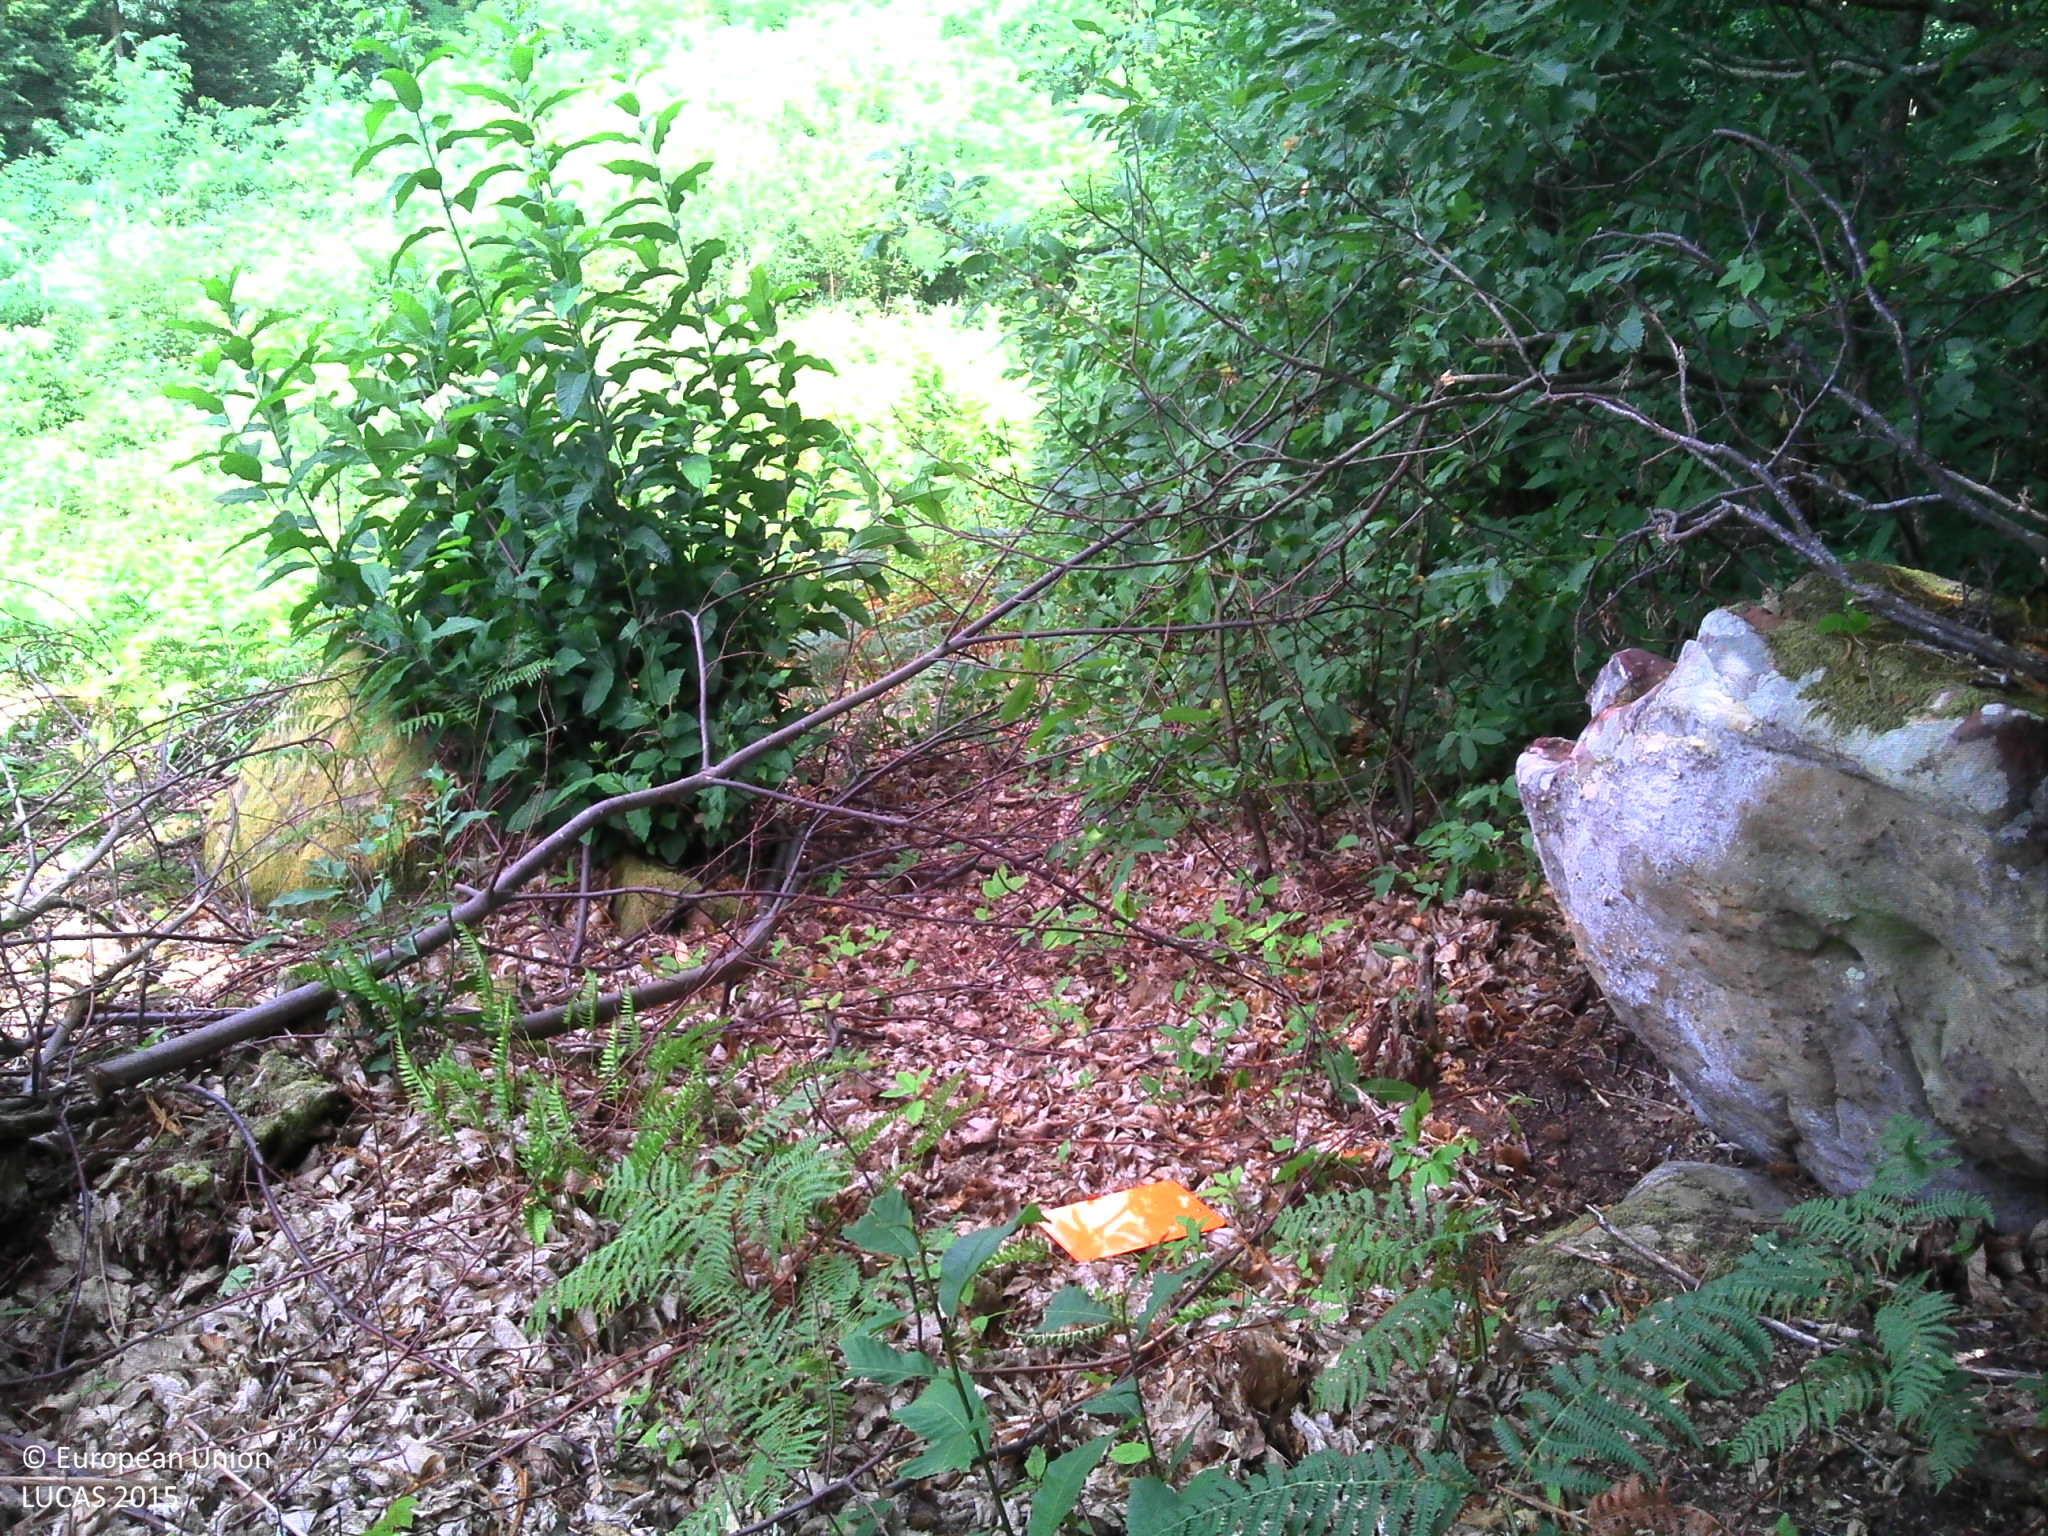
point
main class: Woodland
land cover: Broadleaved woodland
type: thermophilous deciduous forest
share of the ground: > 75 %
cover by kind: broadleaved forest trees 55 %, lichens and mosses 15 %, shrubs 10 %, herbaceous plants 10 %
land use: Forestry
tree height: > 5 m
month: July
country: FR
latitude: 48.4190
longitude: 2.7618
